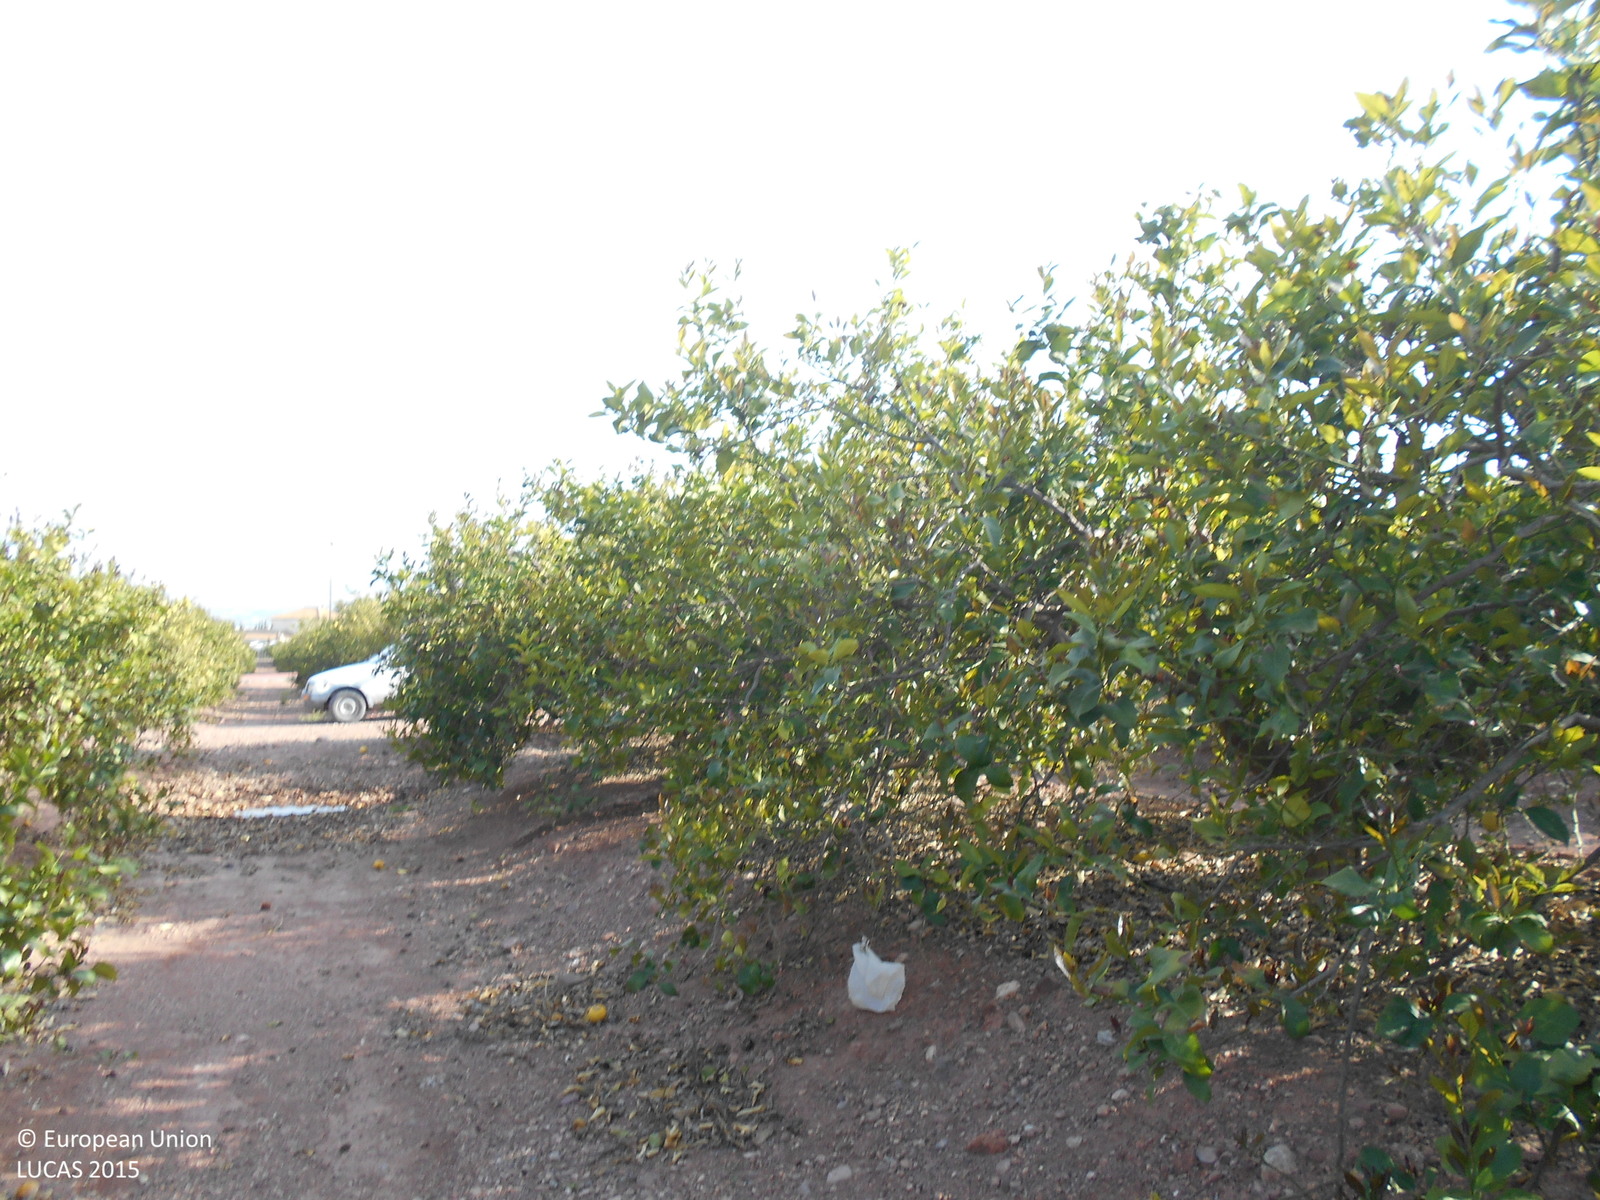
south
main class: Cropland
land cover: Other citrus fruit
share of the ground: > 75 %
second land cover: Other bare soil
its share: > 75 %
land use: Agriculture (excluding fallow land and kitchen gardens)
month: April
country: ES
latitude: 37.7964
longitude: -1.5102
